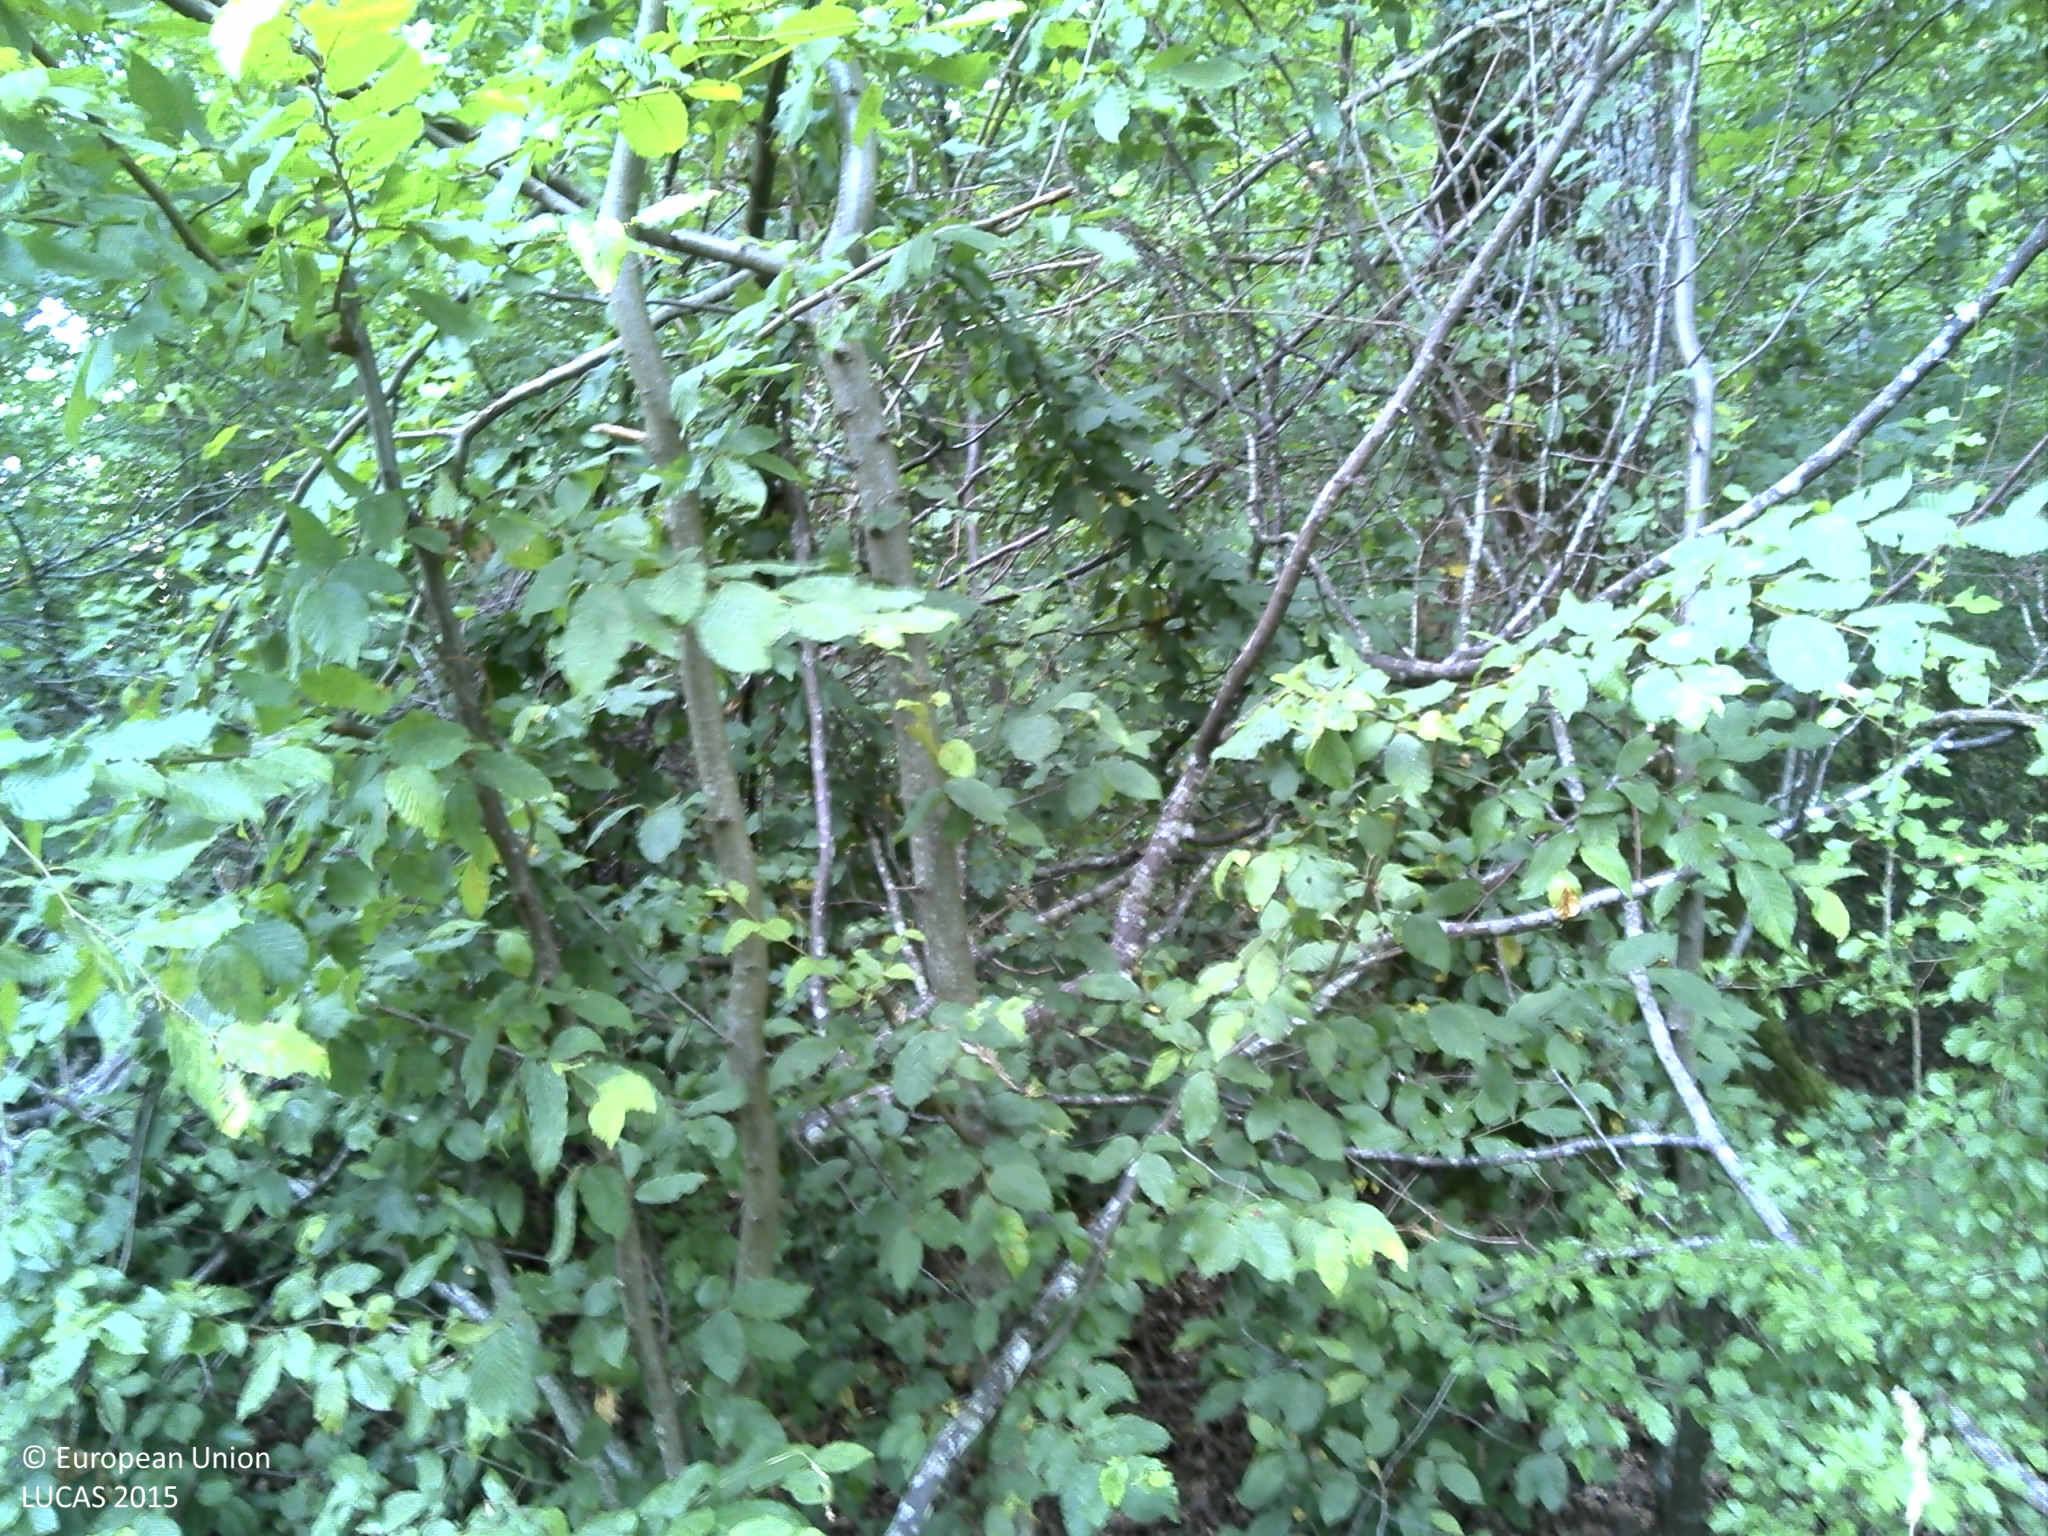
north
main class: Woodland
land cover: Broadleaved woodland
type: acidophilous oak and oak-birch forest
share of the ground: > 75 %
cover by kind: broadleaved forest trees 100 %
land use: Forestry
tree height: > 5 m
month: July
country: FR
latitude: 48.3413
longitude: 6.2902
